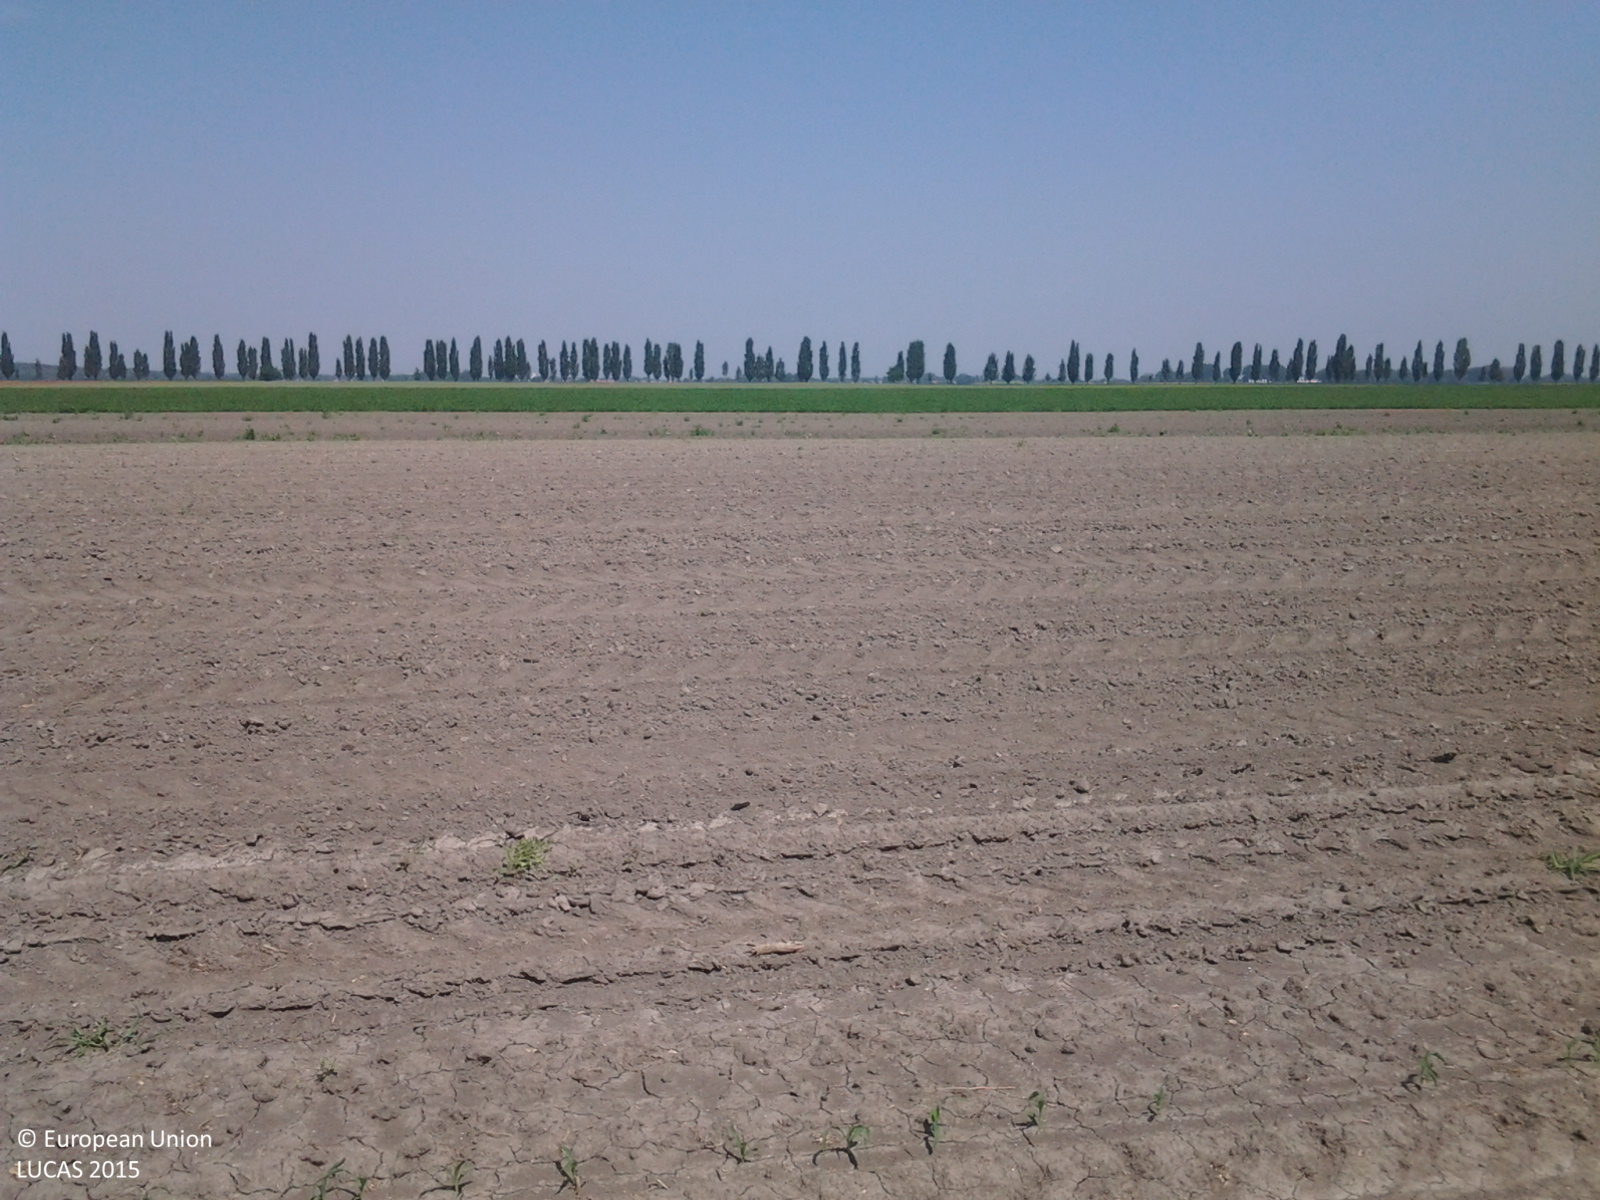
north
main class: Cropland
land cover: Maize
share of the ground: > 75 %
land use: Agriculture (excluding fallow land and kitchen gardens)
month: June
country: HU
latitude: 46.5017
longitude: 18.9392
